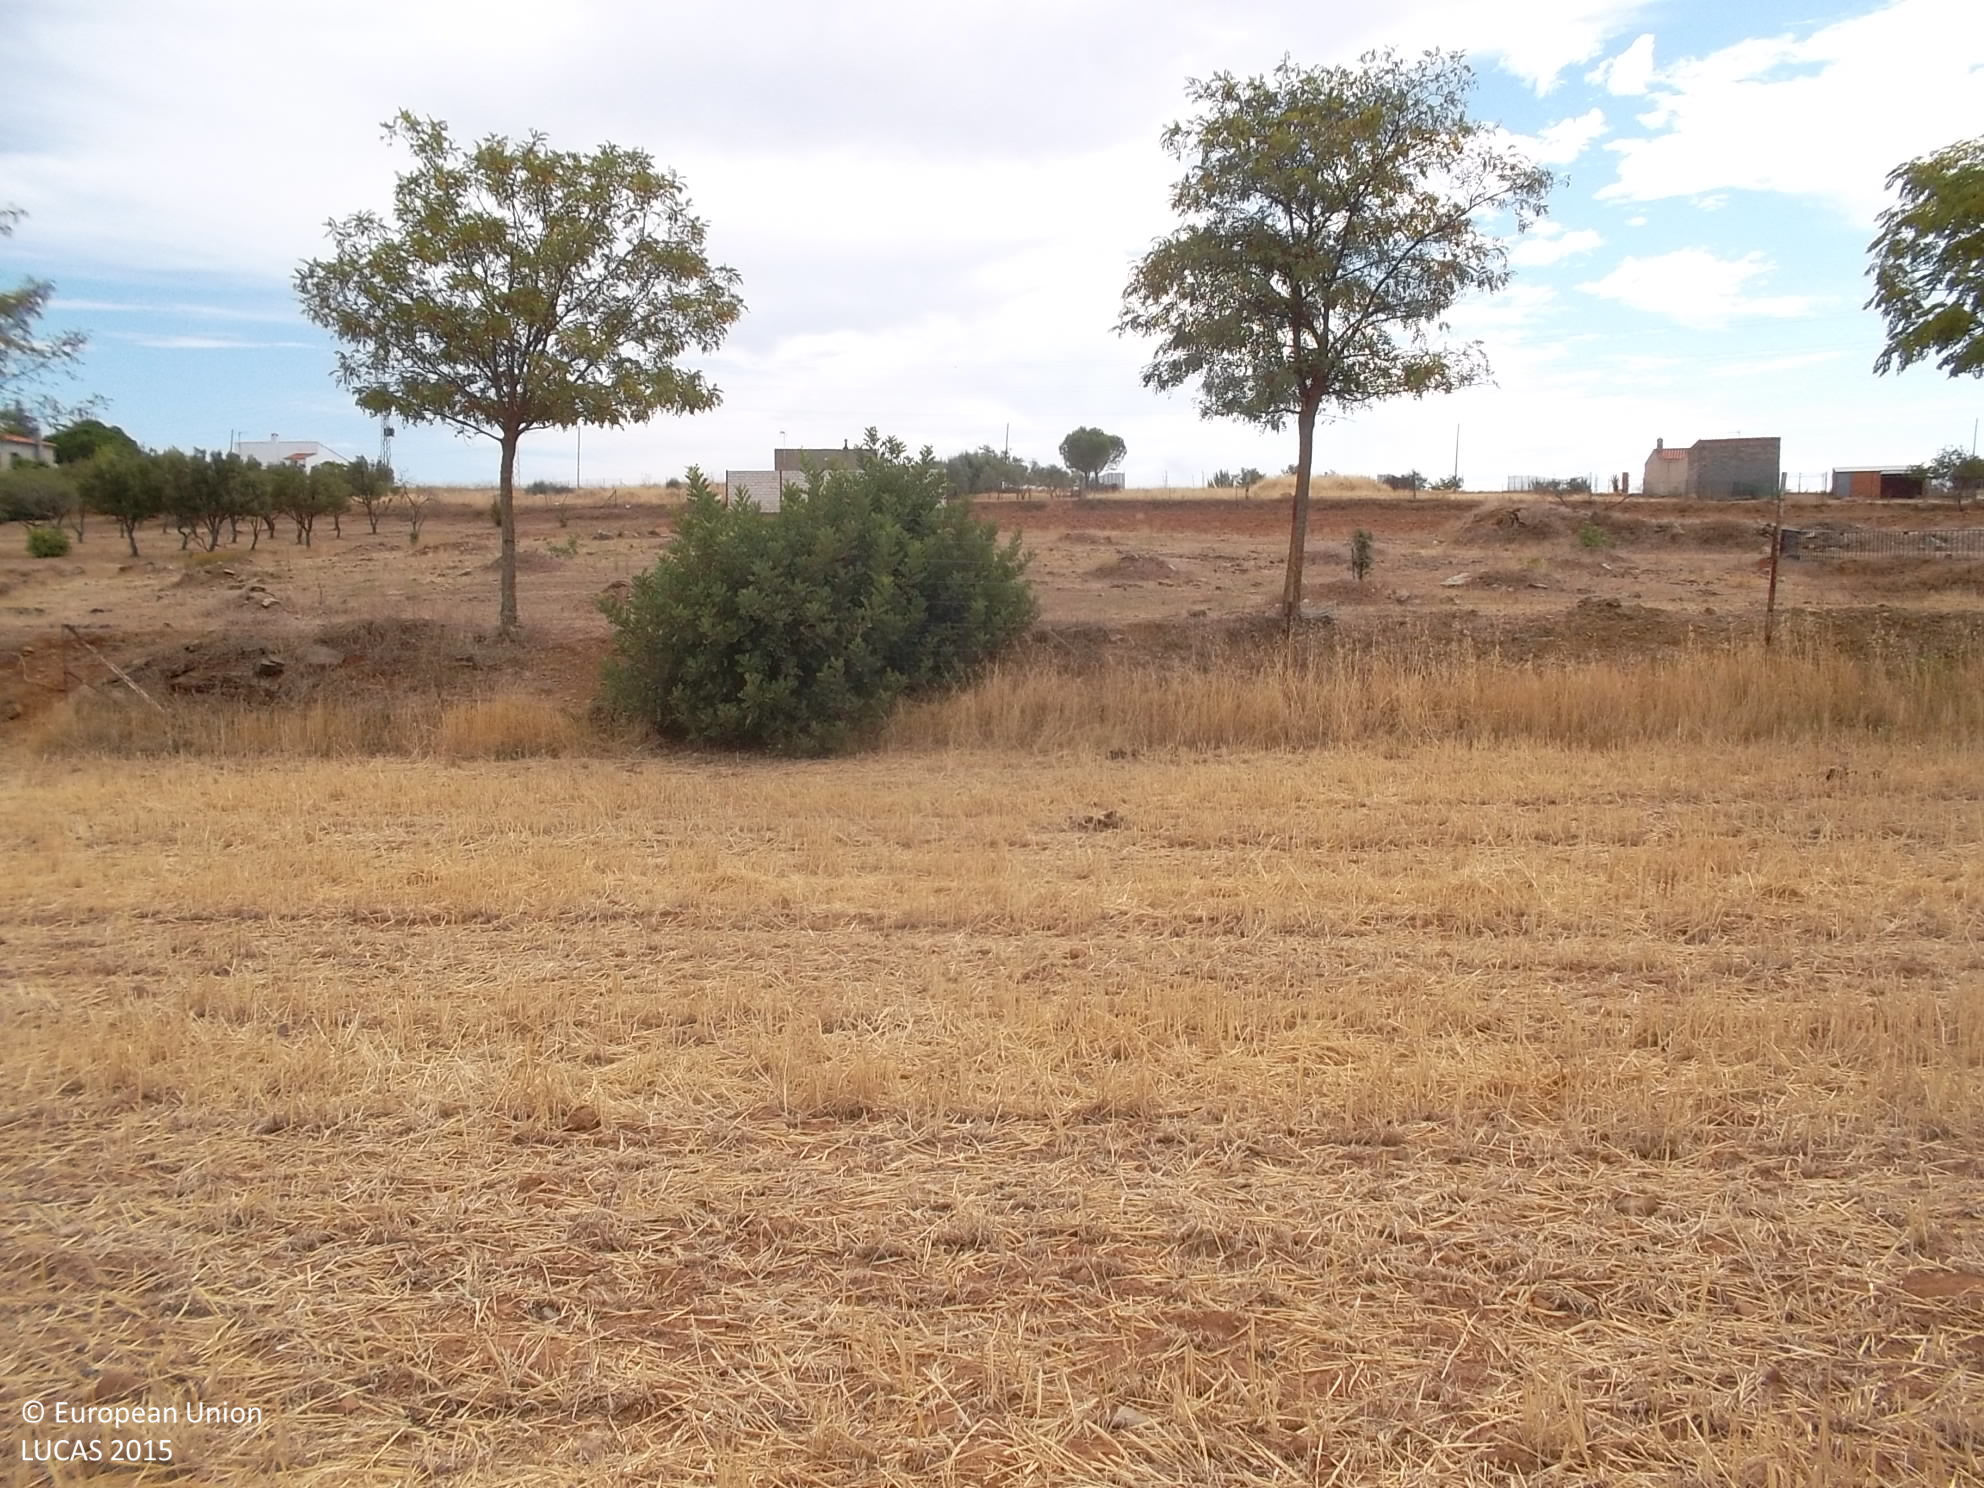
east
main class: Cropland
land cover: Common wheat
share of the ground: < 10 %
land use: Agriculture (excluding fallow land and kitchen gardens)
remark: Harvested field
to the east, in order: Common wheat; Fences; Abandoned hedges; Tracks; Other bare soil; Fences; Other bare soil; Fences; Other bare soil; Fences; Tracks; Fences; Spontaneously vegetated surfaces; Tracks; Fences; Spontaneously vegetated surfaces
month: September
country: ES
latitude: 38.3956
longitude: -6.4116
